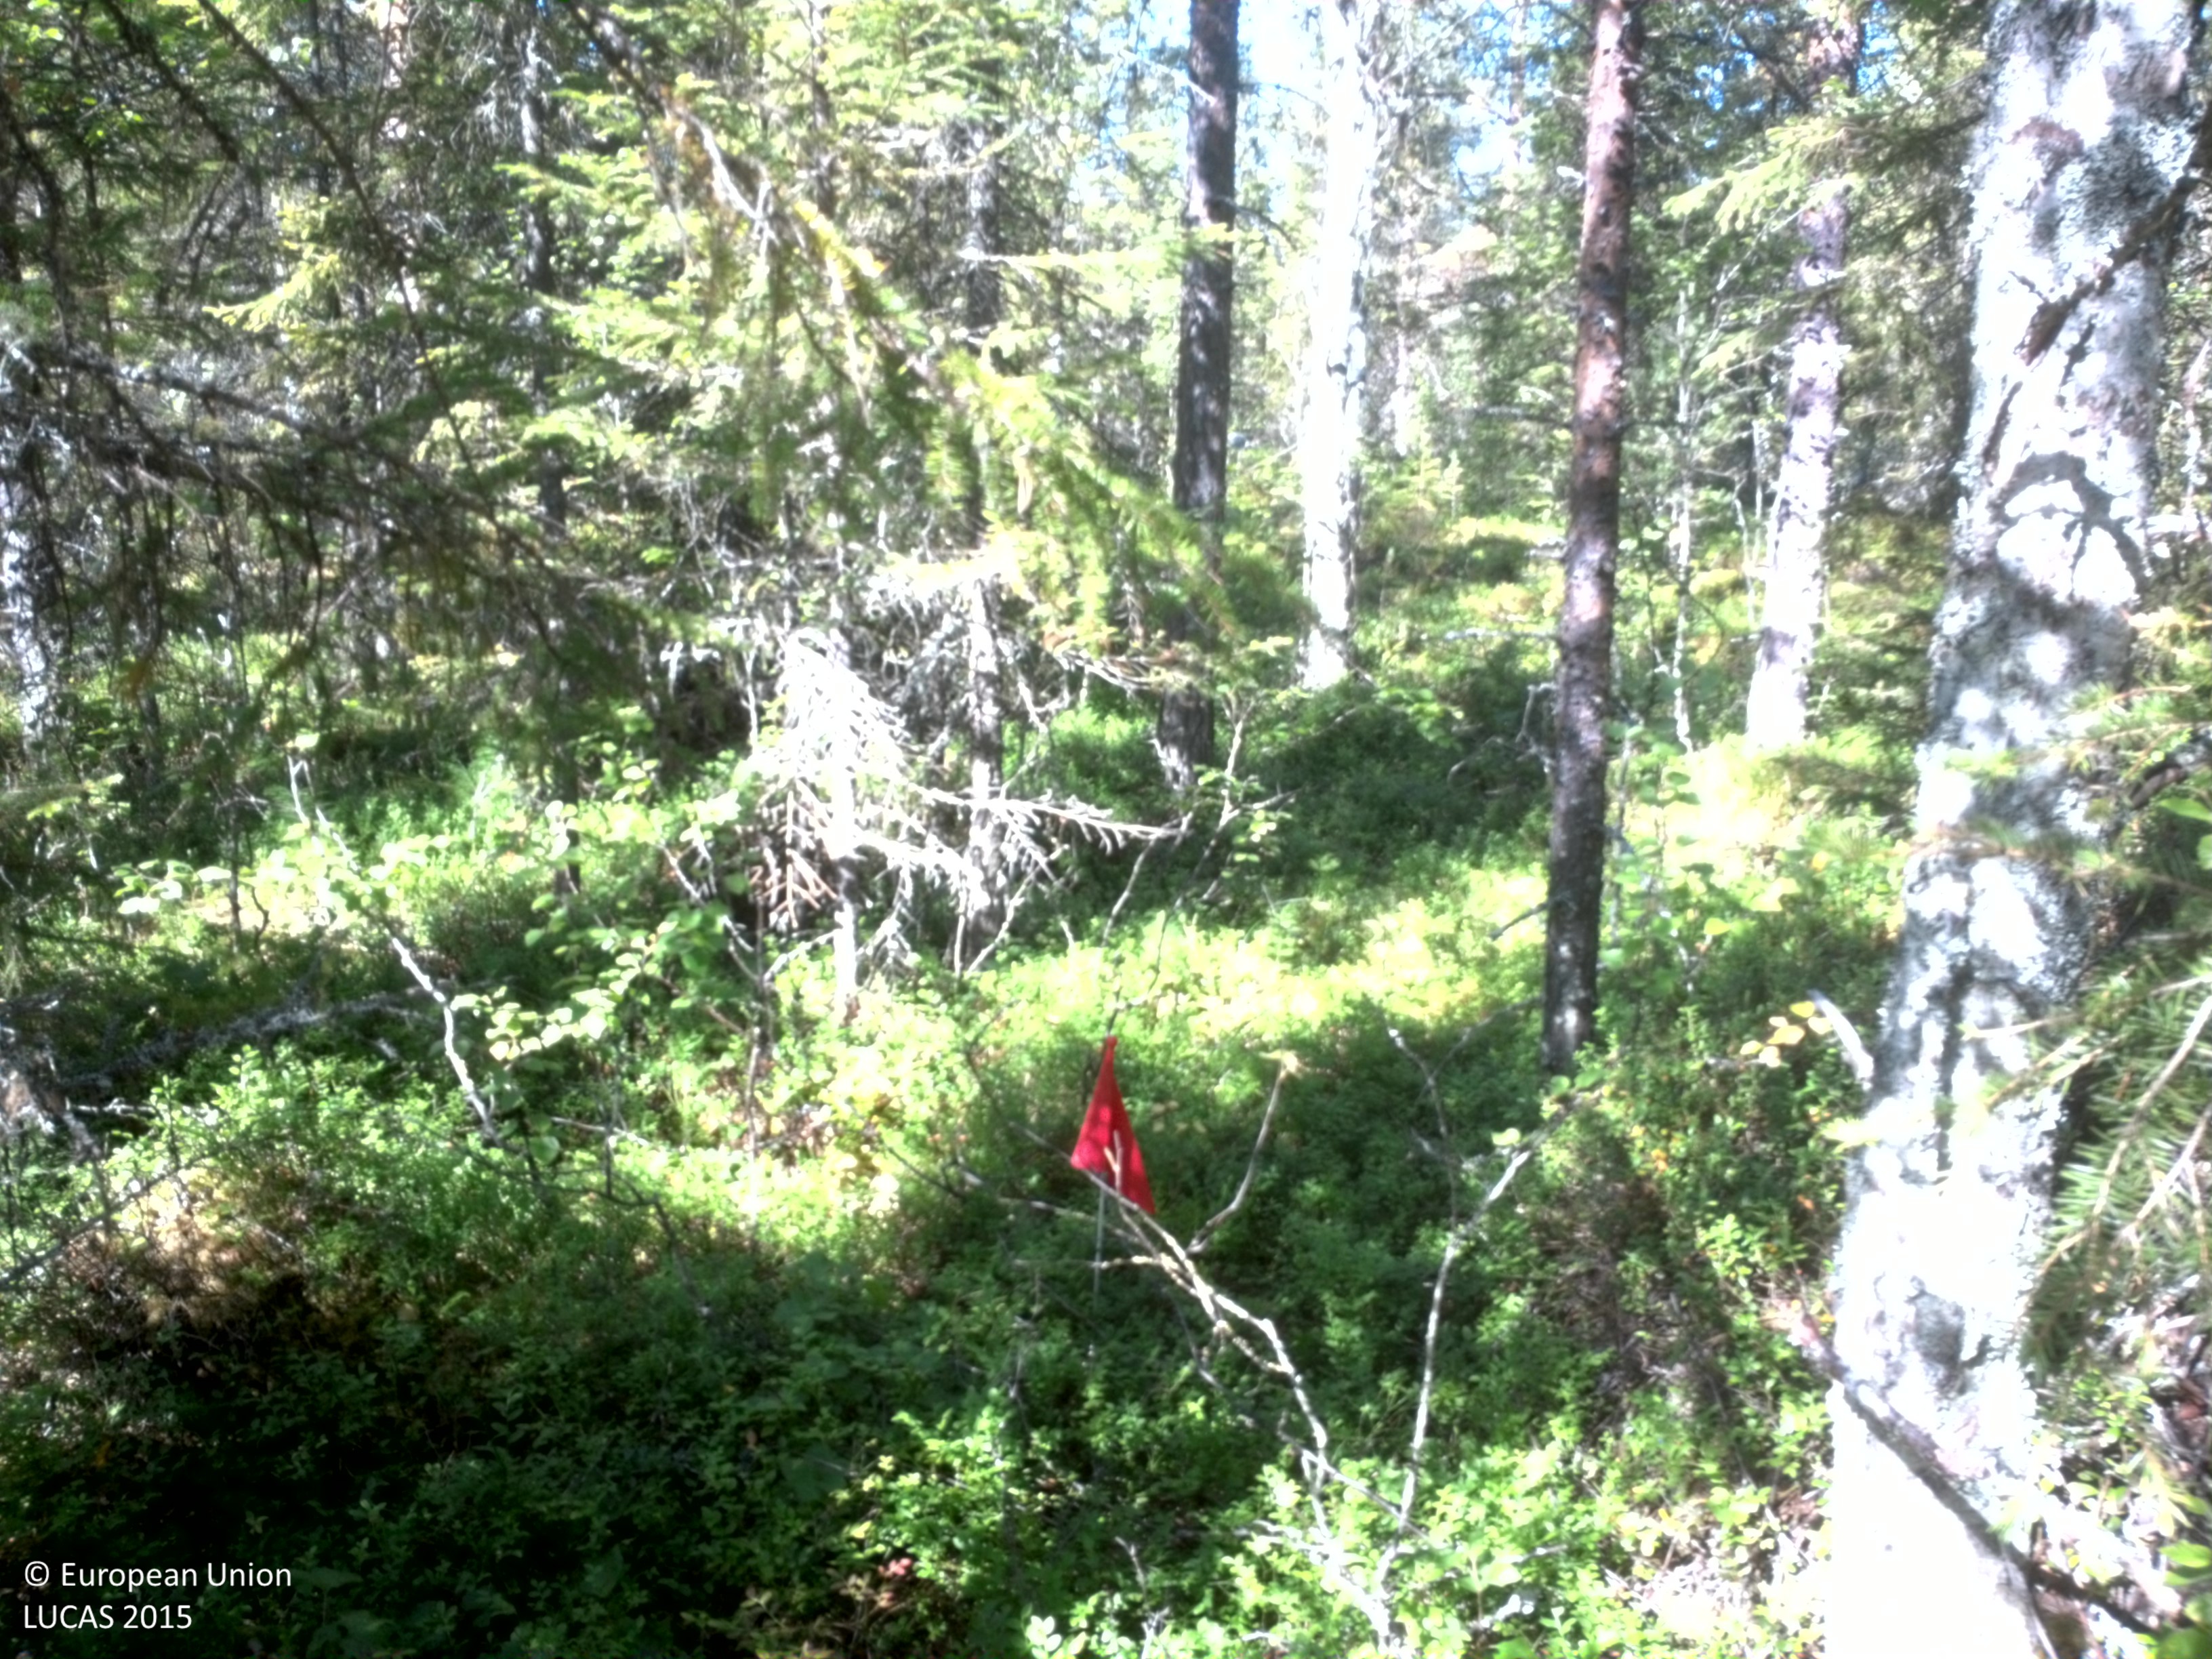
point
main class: Woodland
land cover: Pine dominated mixed woodland
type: boreal forest
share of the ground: 50 - 75 %
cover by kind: coniferous forest trees 45 %, shrubs 30 %, broadleaved forest trees 15 %, herbaceous plants 5 %, lichens and mosses 5 %
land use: Forestry
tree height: > 5 m
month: August
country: SE
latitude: 64.4847
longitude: 18.3951
